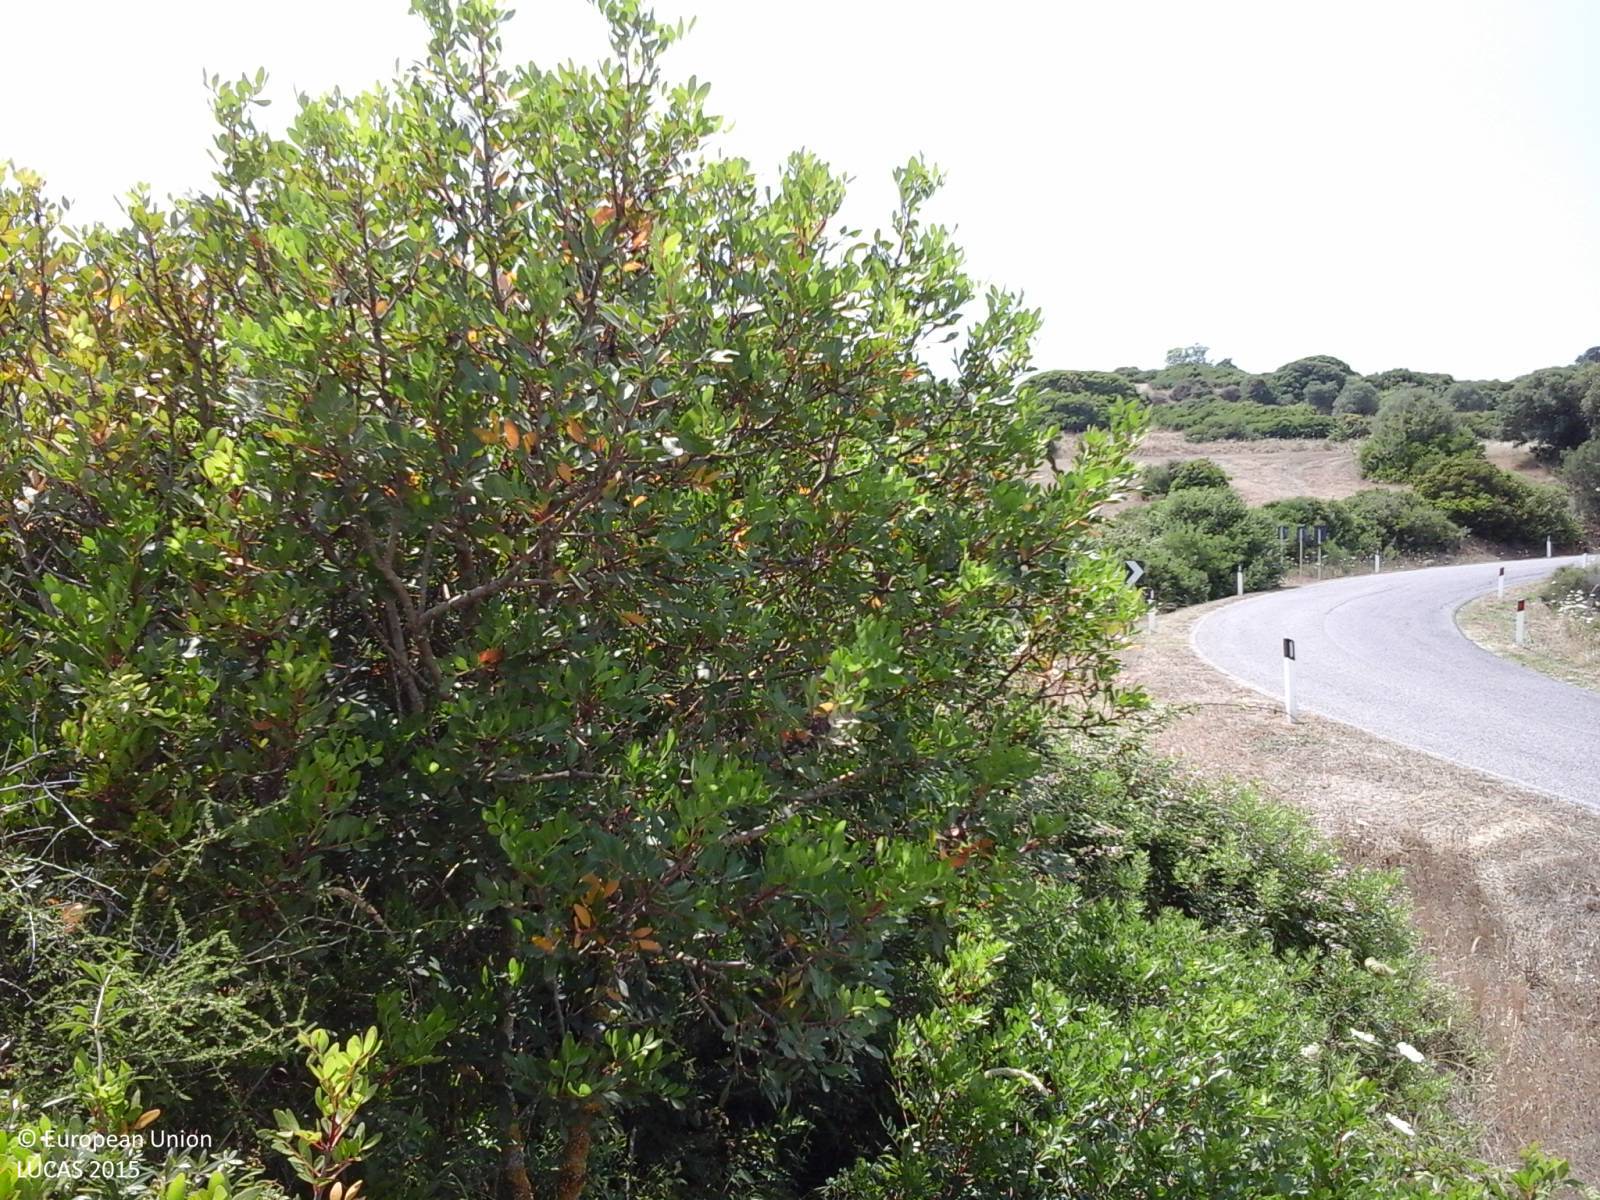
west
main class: Grassland
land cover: Grassland without tree/shrub cover
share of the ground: > 75 %
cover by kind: herbaceous plants 100 %
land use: Agriculture (excluding fallow land and kitchen gardens)
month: June
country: IT
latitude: 39.8627
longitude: 8.8956
